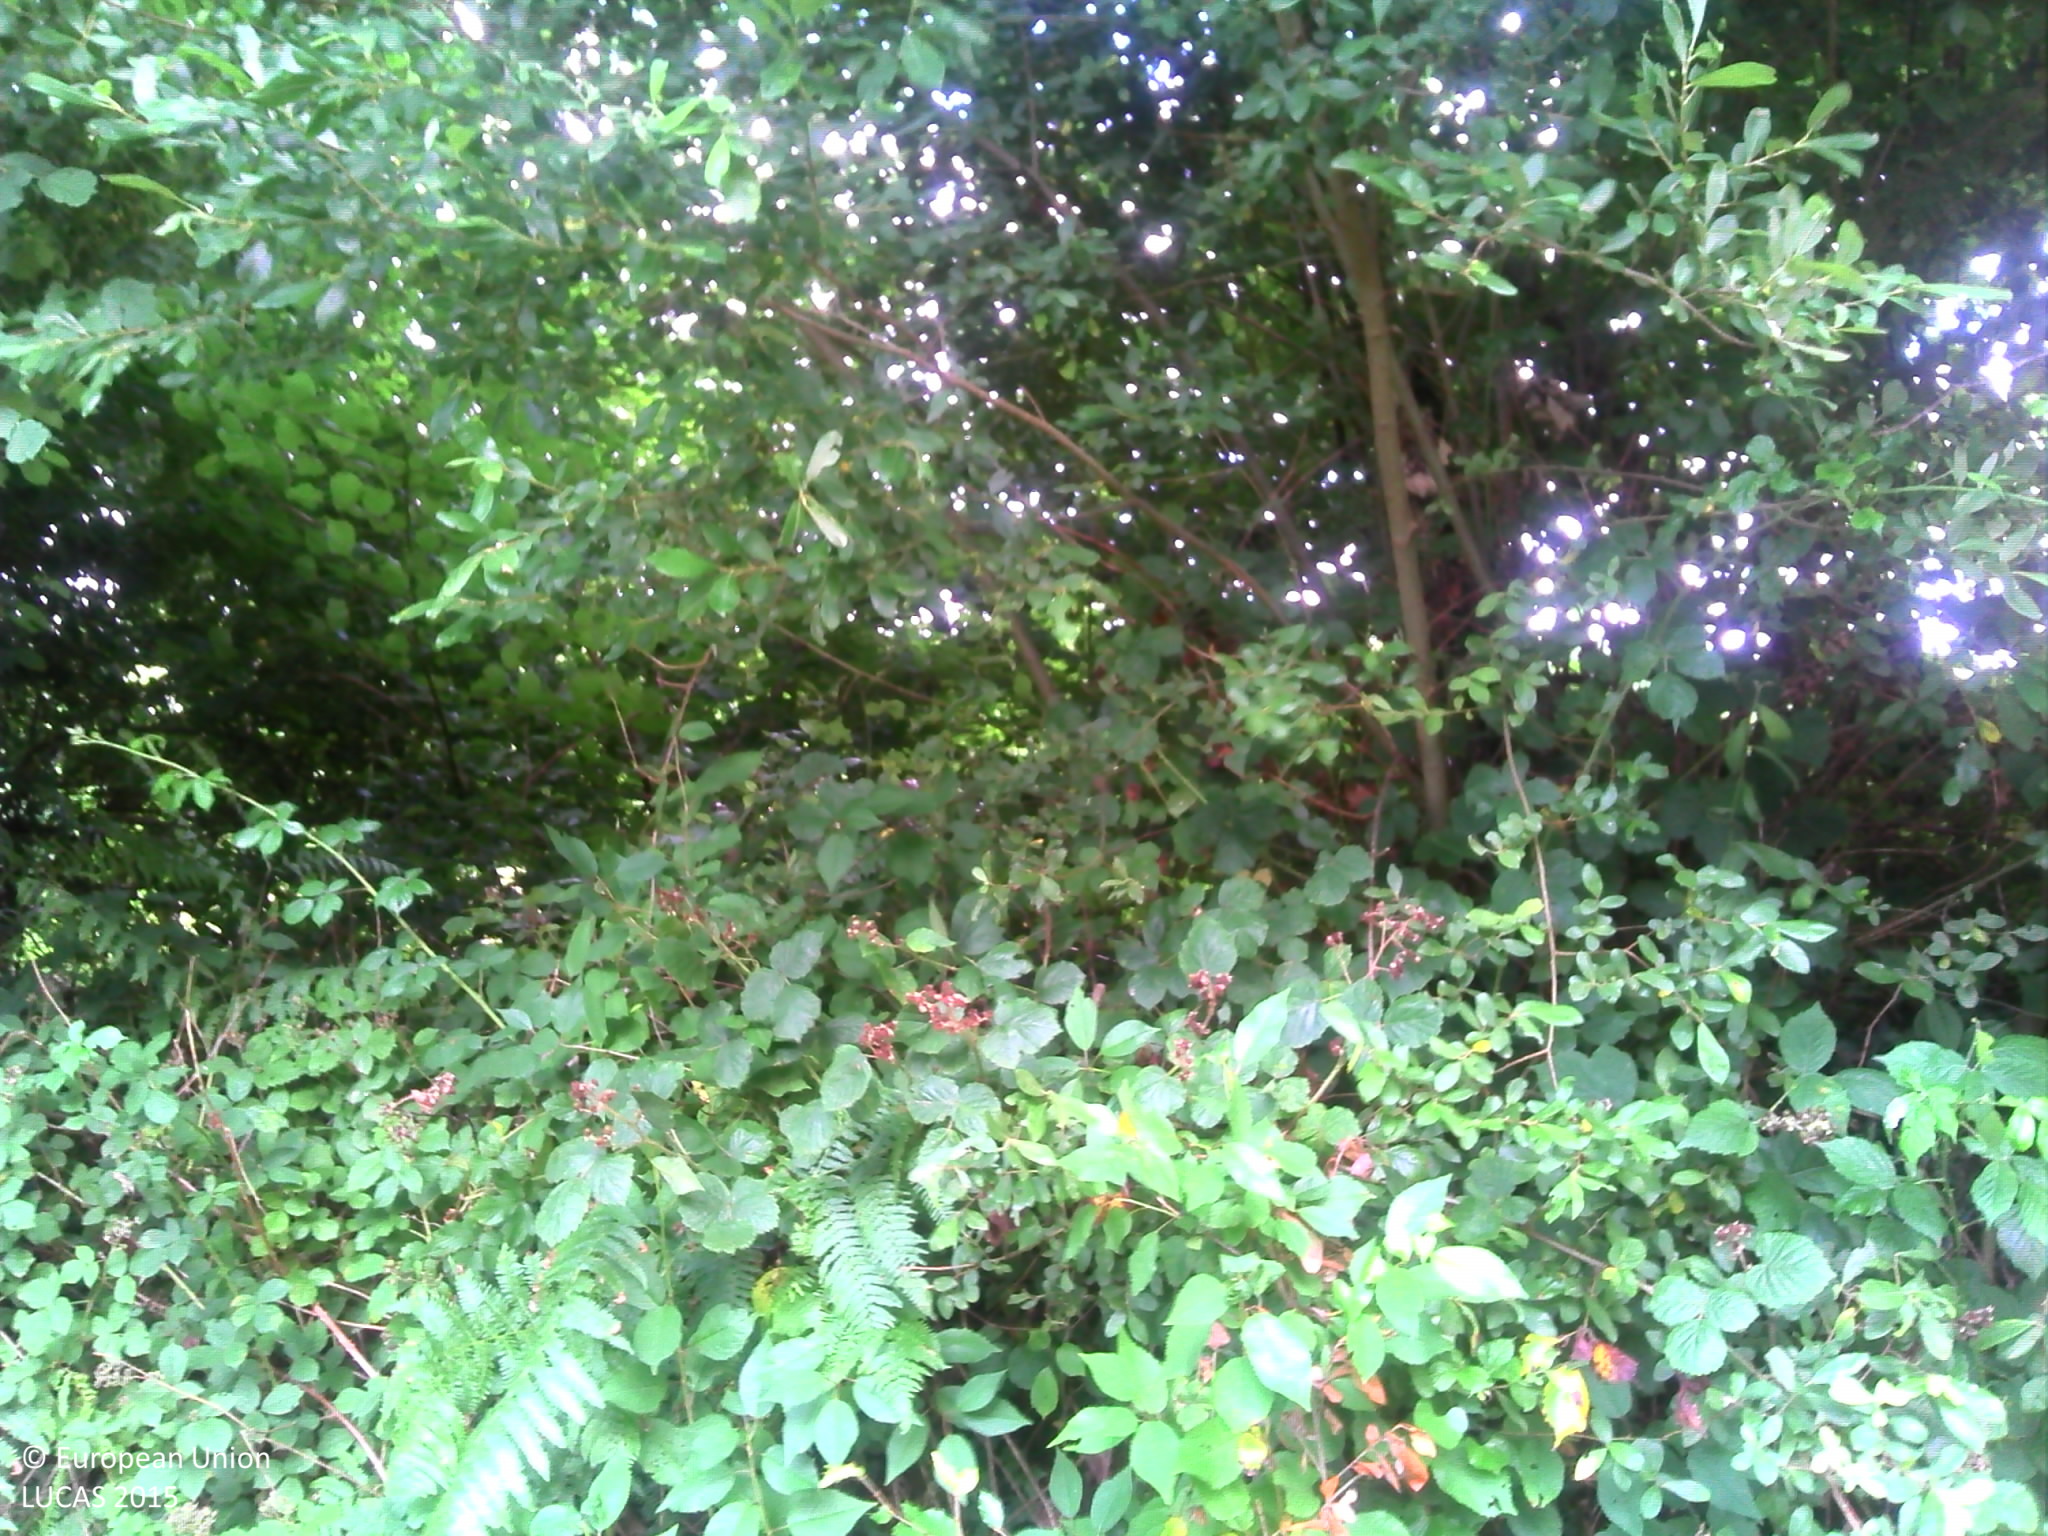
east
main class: Grassland
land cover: Grassland without tree/shrub cover
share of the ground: > 75 %
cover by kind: herbaceous plants 100 %
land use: Agriculture (excluding fallow land and kitchen gardens)
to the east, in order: Grassland without tree/shrub cover; Fences; Lines of trees; Grassland without tree/shrub cover; Fences; Lines of trees; Maize; Electric lines; Maize; Broadleaved woodland
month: July
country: FR
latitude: 48.5087
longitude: -3.4379
